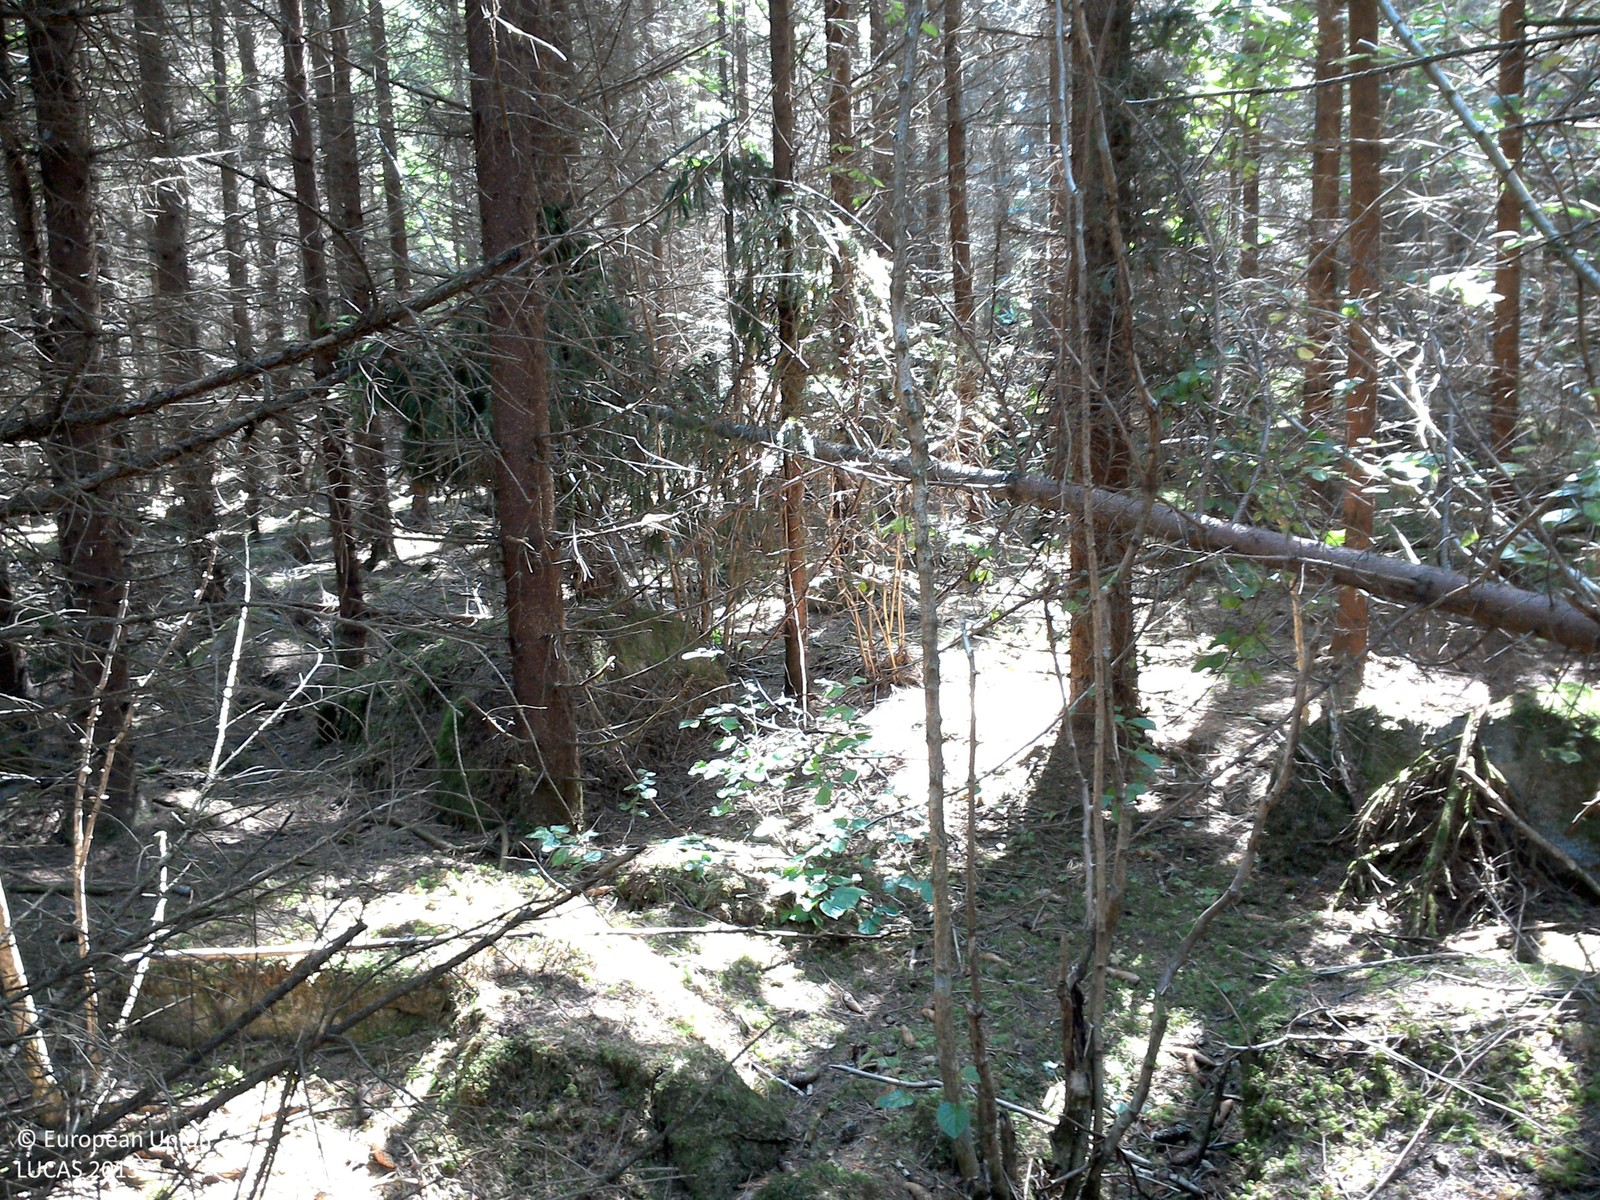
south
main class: Woodland
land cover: Spruce dominated coniferous woodland
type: boreal forest
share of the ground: > 75 %
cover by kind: coniferous forest trees 80 %, lichens and mosses 20 %
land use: Forestry
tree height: > 5 m
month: July
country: SE
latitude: 58.0871
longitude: 14.5907
